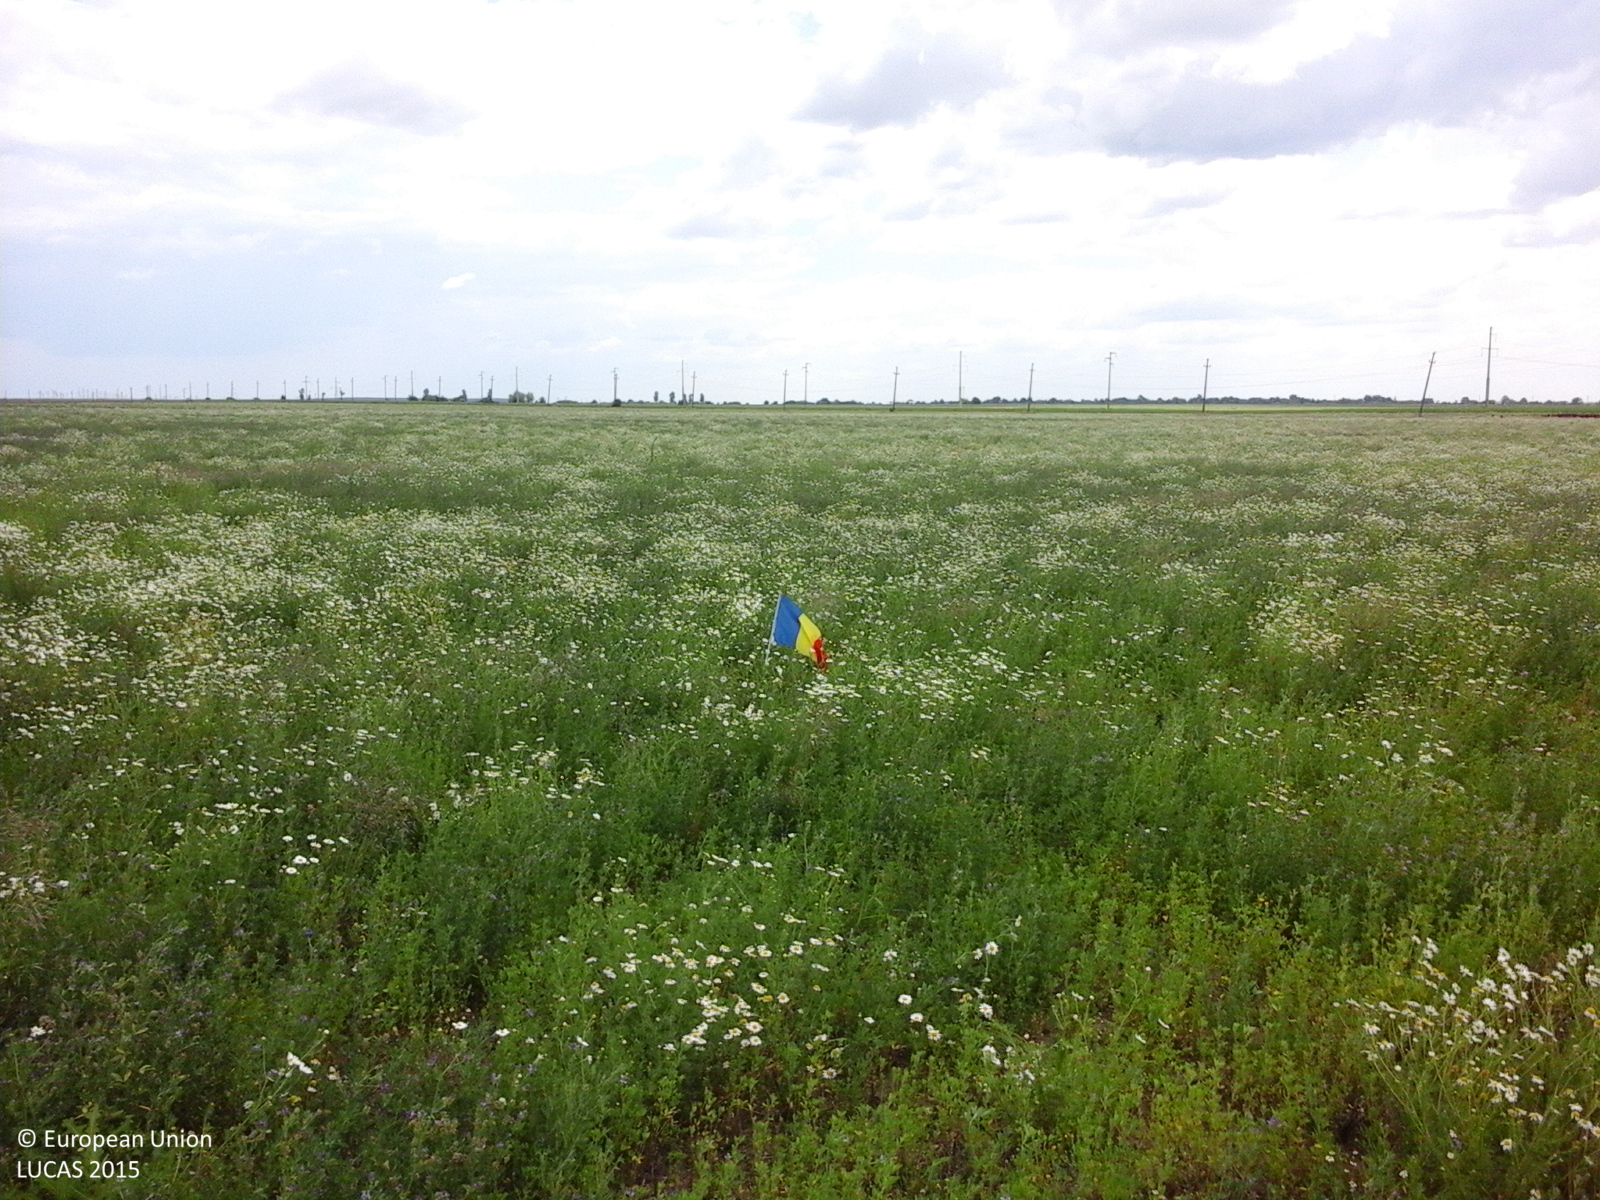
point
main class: Cropland
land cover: Lucerne
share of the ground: > 75 %
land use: Agriculture (excluding fallow land and kitchen gardens)
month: July
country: RO
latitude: 44.2951
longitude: 25.2623
